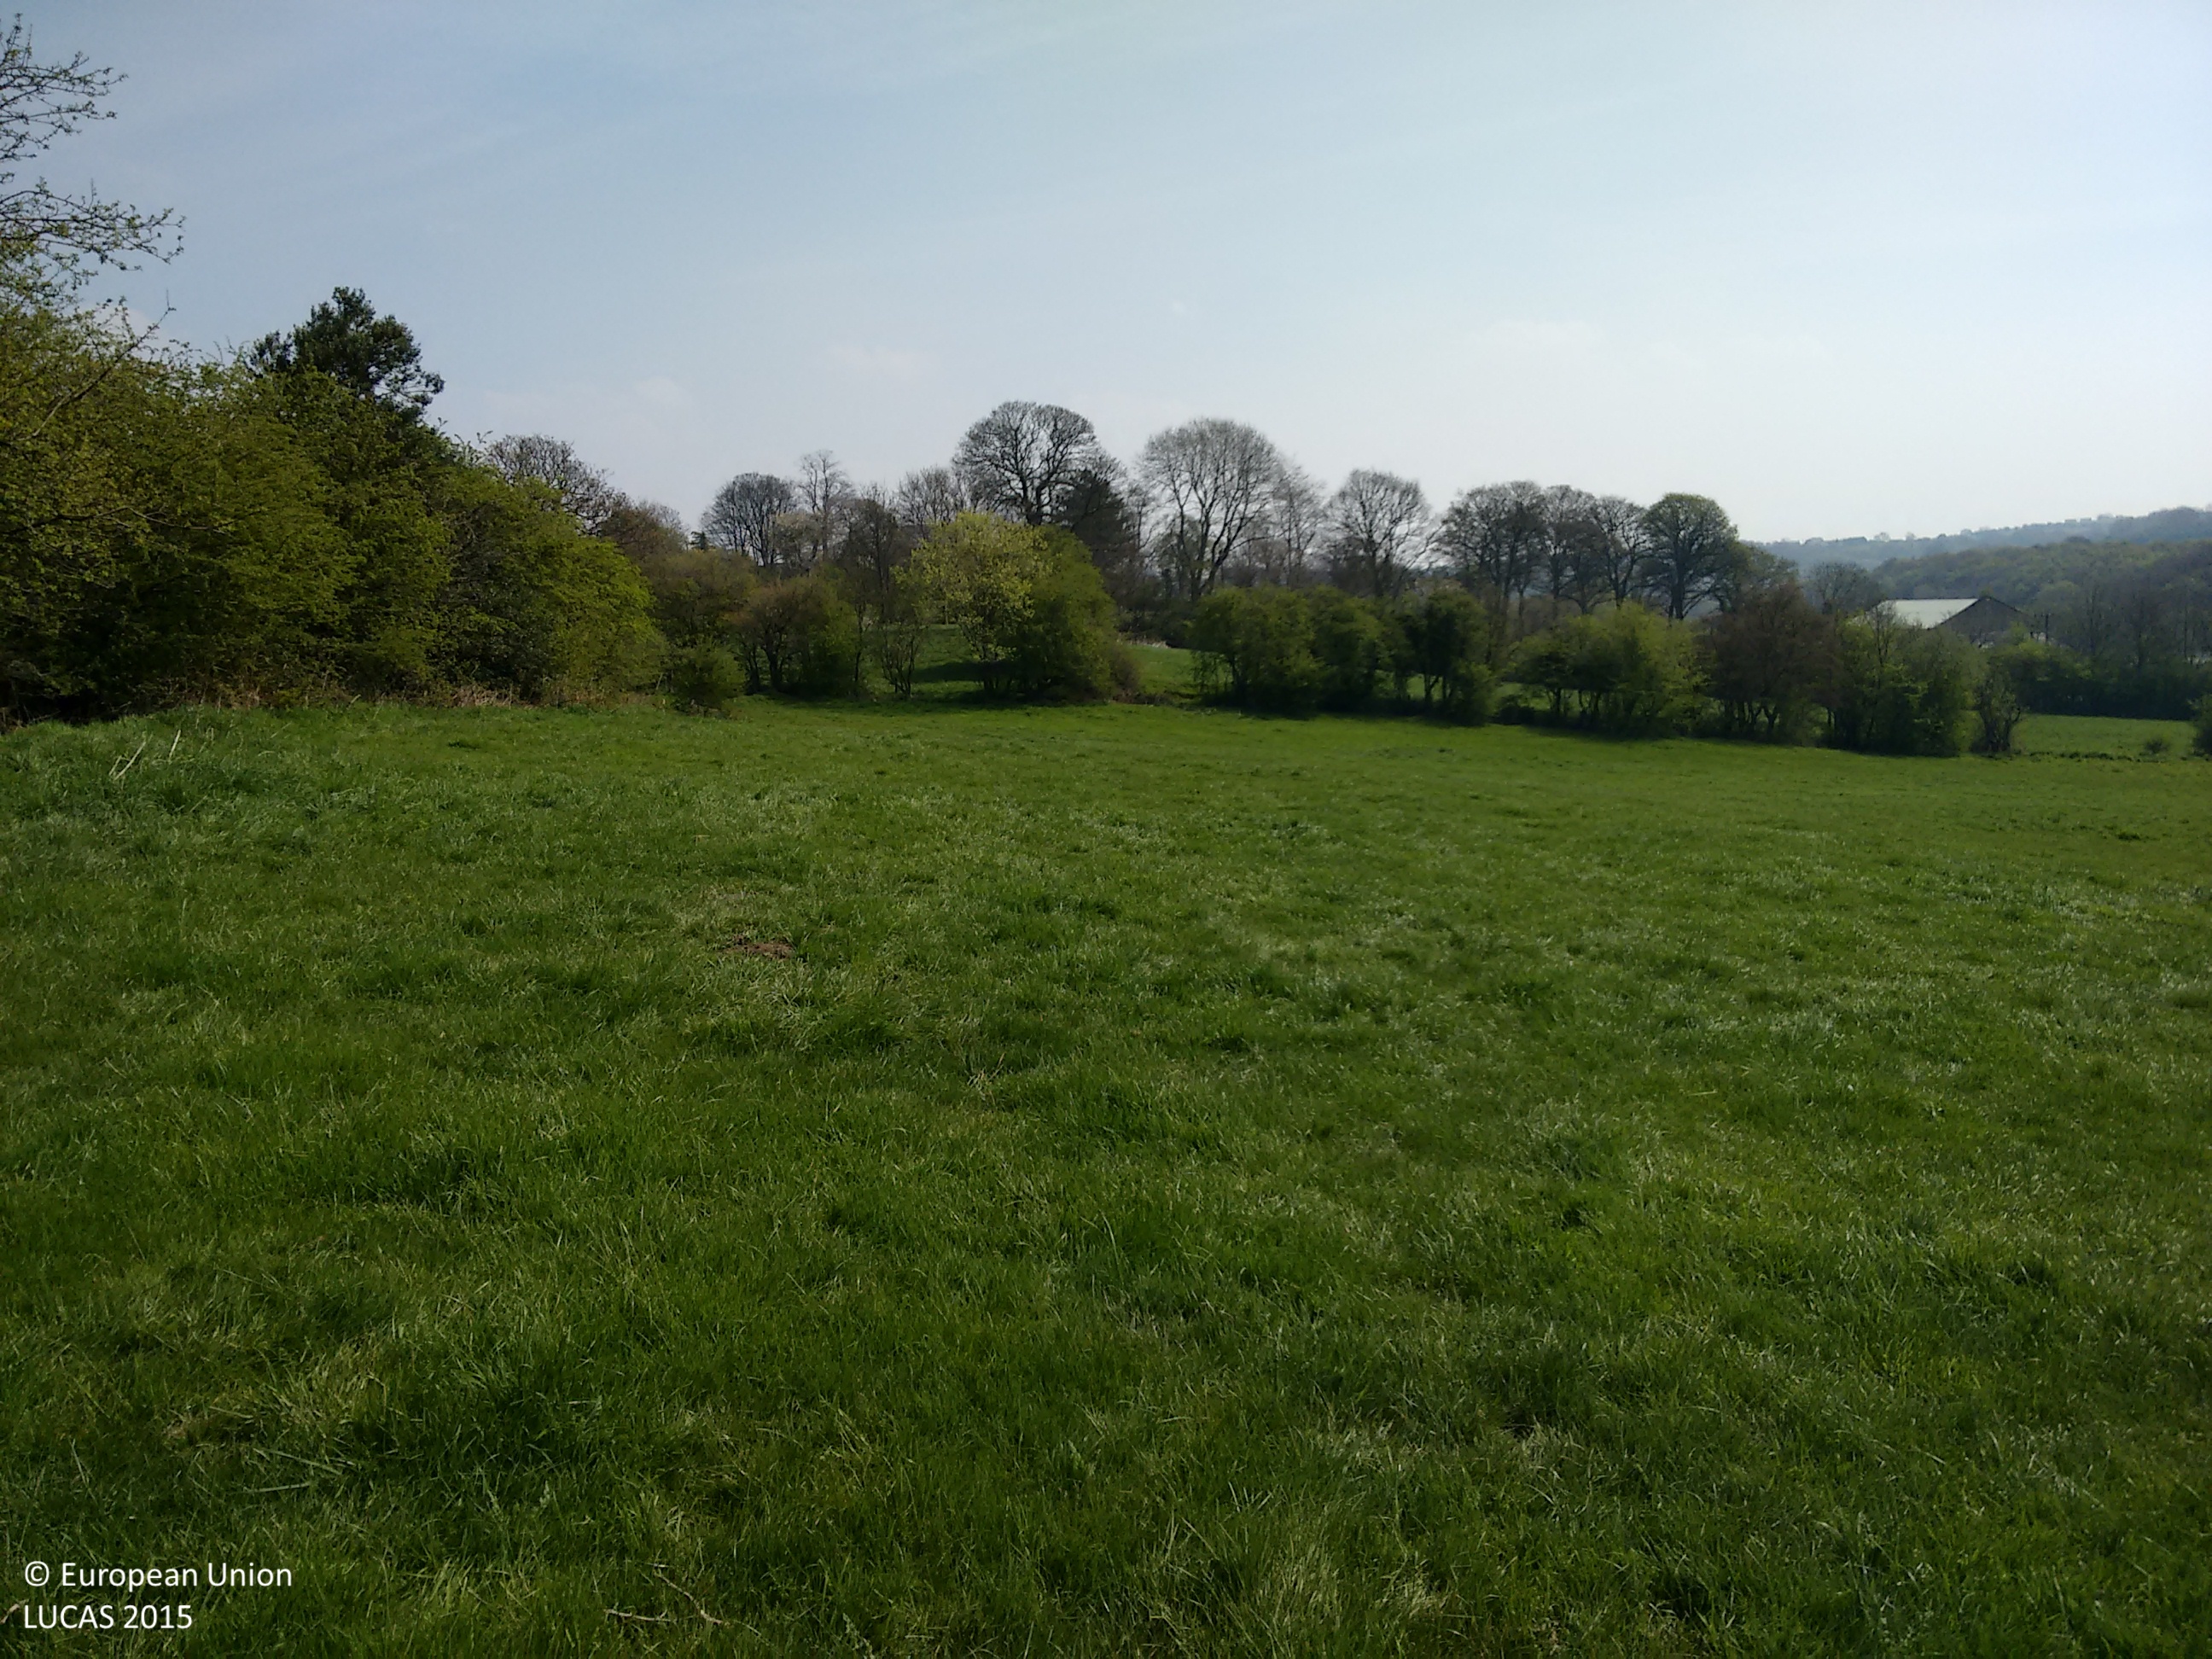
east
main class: Grassland
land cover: Grassland without tree/shrub cover
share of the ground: > 75 %
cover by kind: herbaceous plants 100 %
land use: Agriculture (excluding fallow land and kitchen gardens)
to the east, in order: Grassland without tree/shrub cover; Abandoned hedges; Grassland without tree/shrub cover; Fences; Abandoned hedges; Ditches and canals; Abandoned hedges; Grassland without tree/shrub cover
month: April
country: GB
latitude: 53.7813
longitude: -1.6618
